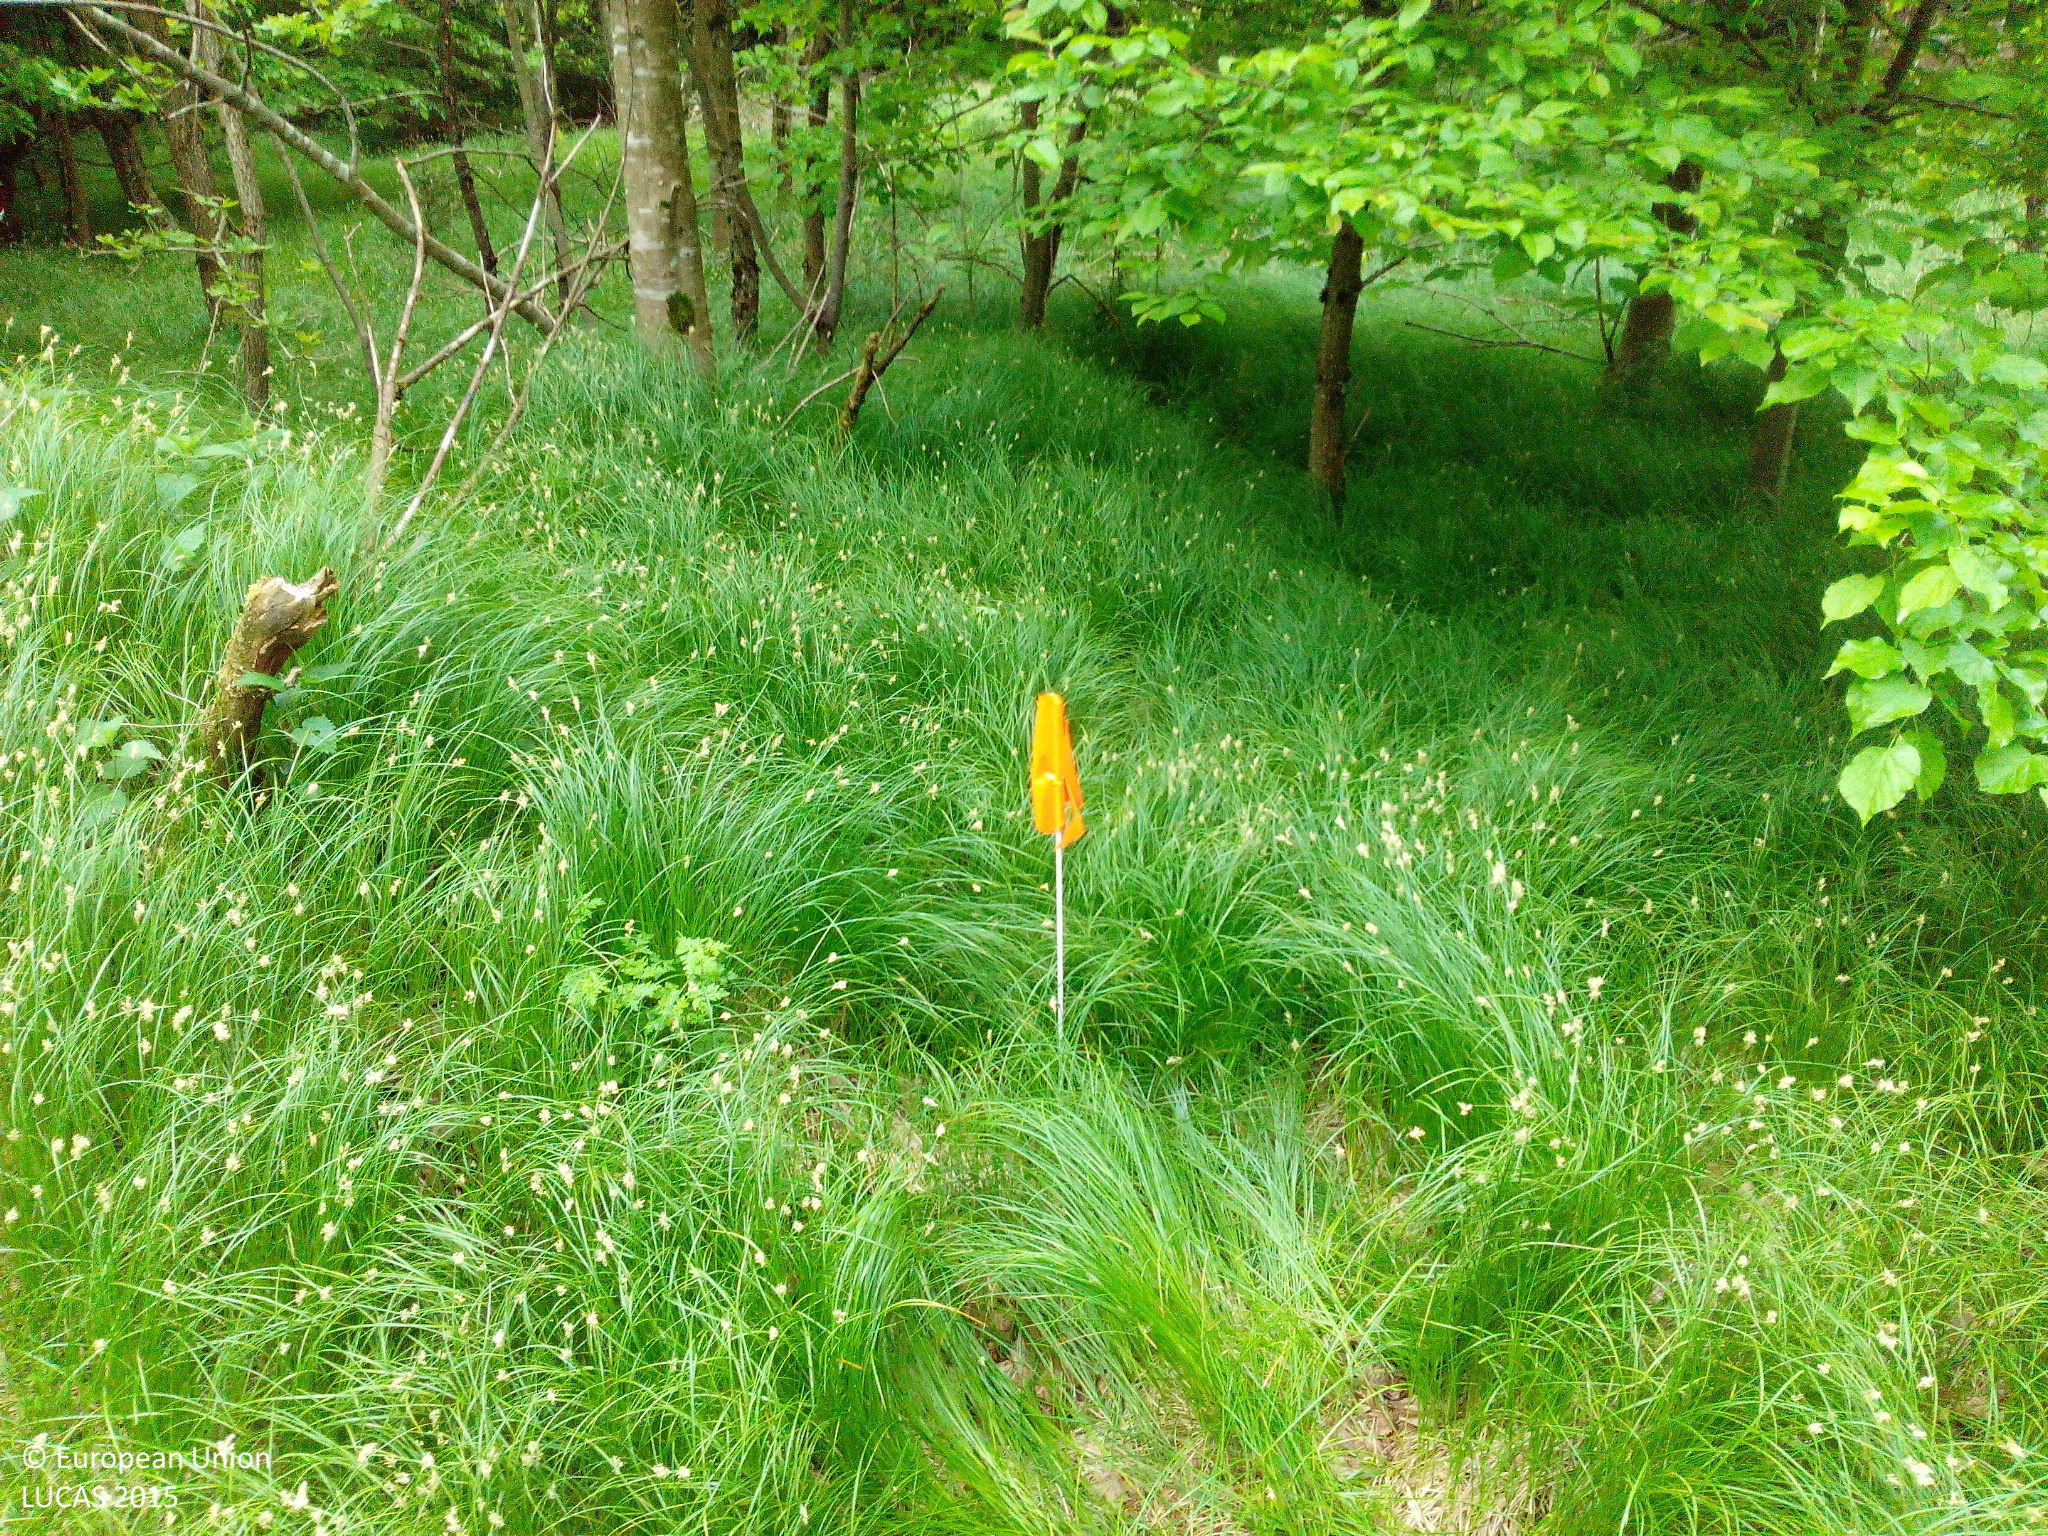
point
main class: Woodland
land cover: Broadleaved woodland
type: mesophytic deciduous forest
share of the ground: > 75 %
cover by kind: broadleaved forest trees 75 %, herbaceous plants 20 %, coniferous forest trees 5 %
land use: Forestry
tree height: > 5 m
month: May
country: DE
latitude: 48.0436
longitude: 9.9330
